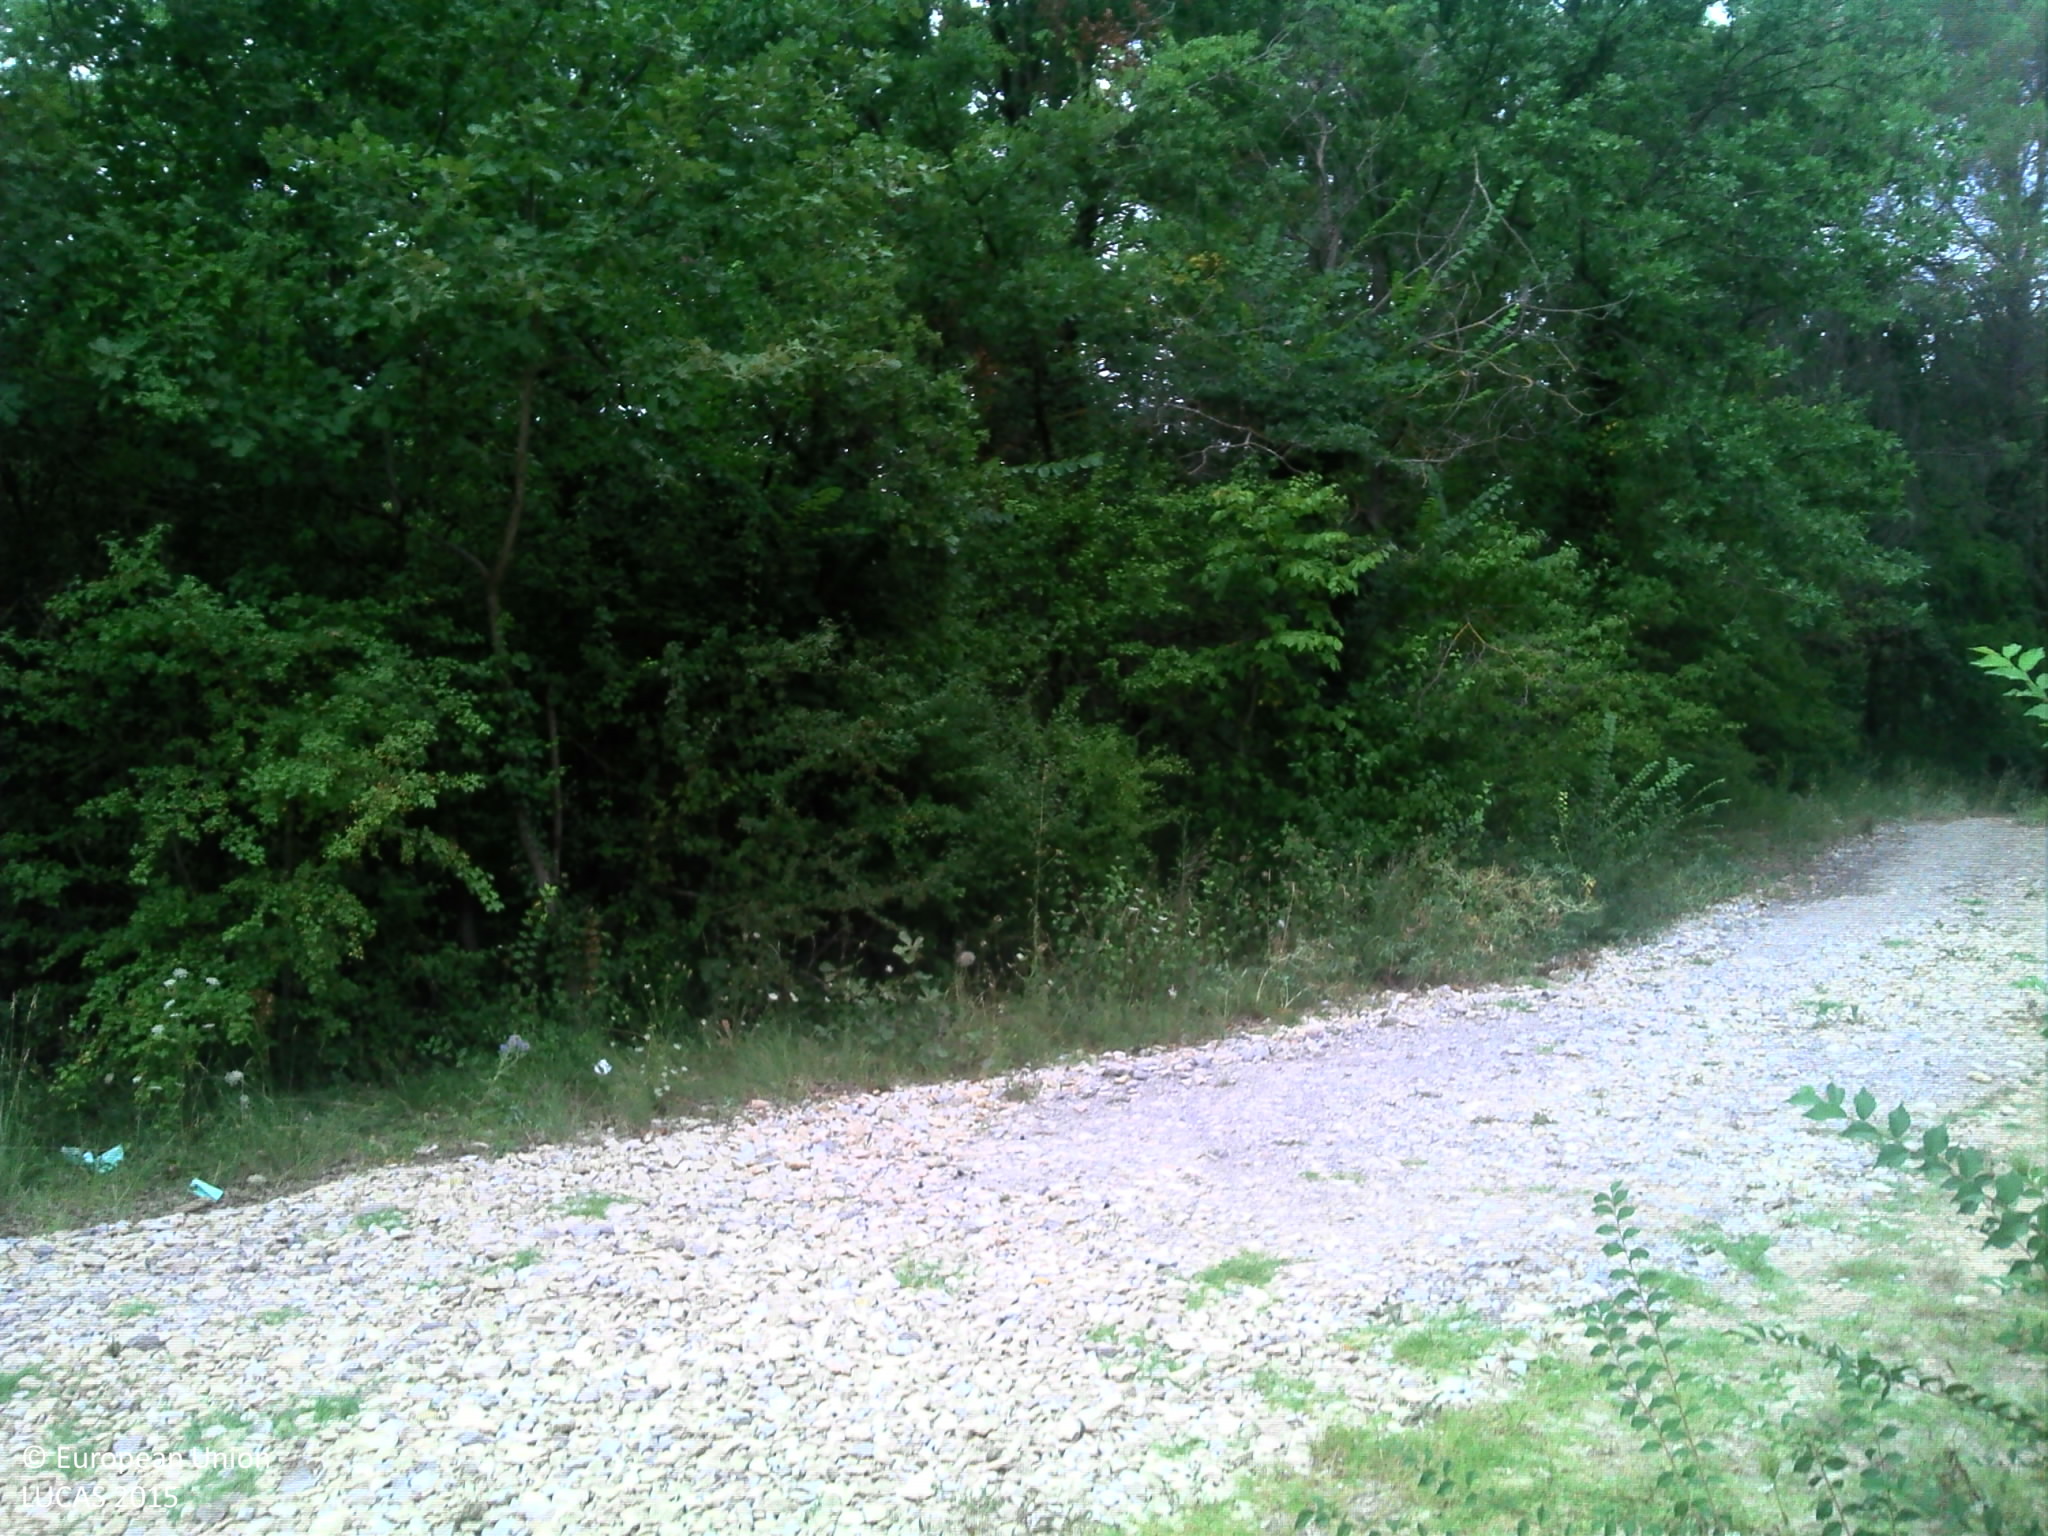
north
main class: Woodland
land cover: Pine dominated mixed woodland
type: mesophytic deciduous forest
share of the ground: > 75 %
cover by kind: coniferous forest trees 45 %, broadleaved forest trees 35 %, herbaceous plants 20 %
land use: Forestry
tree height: < 5 m
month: October
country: FR
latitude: 43.4601
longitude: 5.5480
